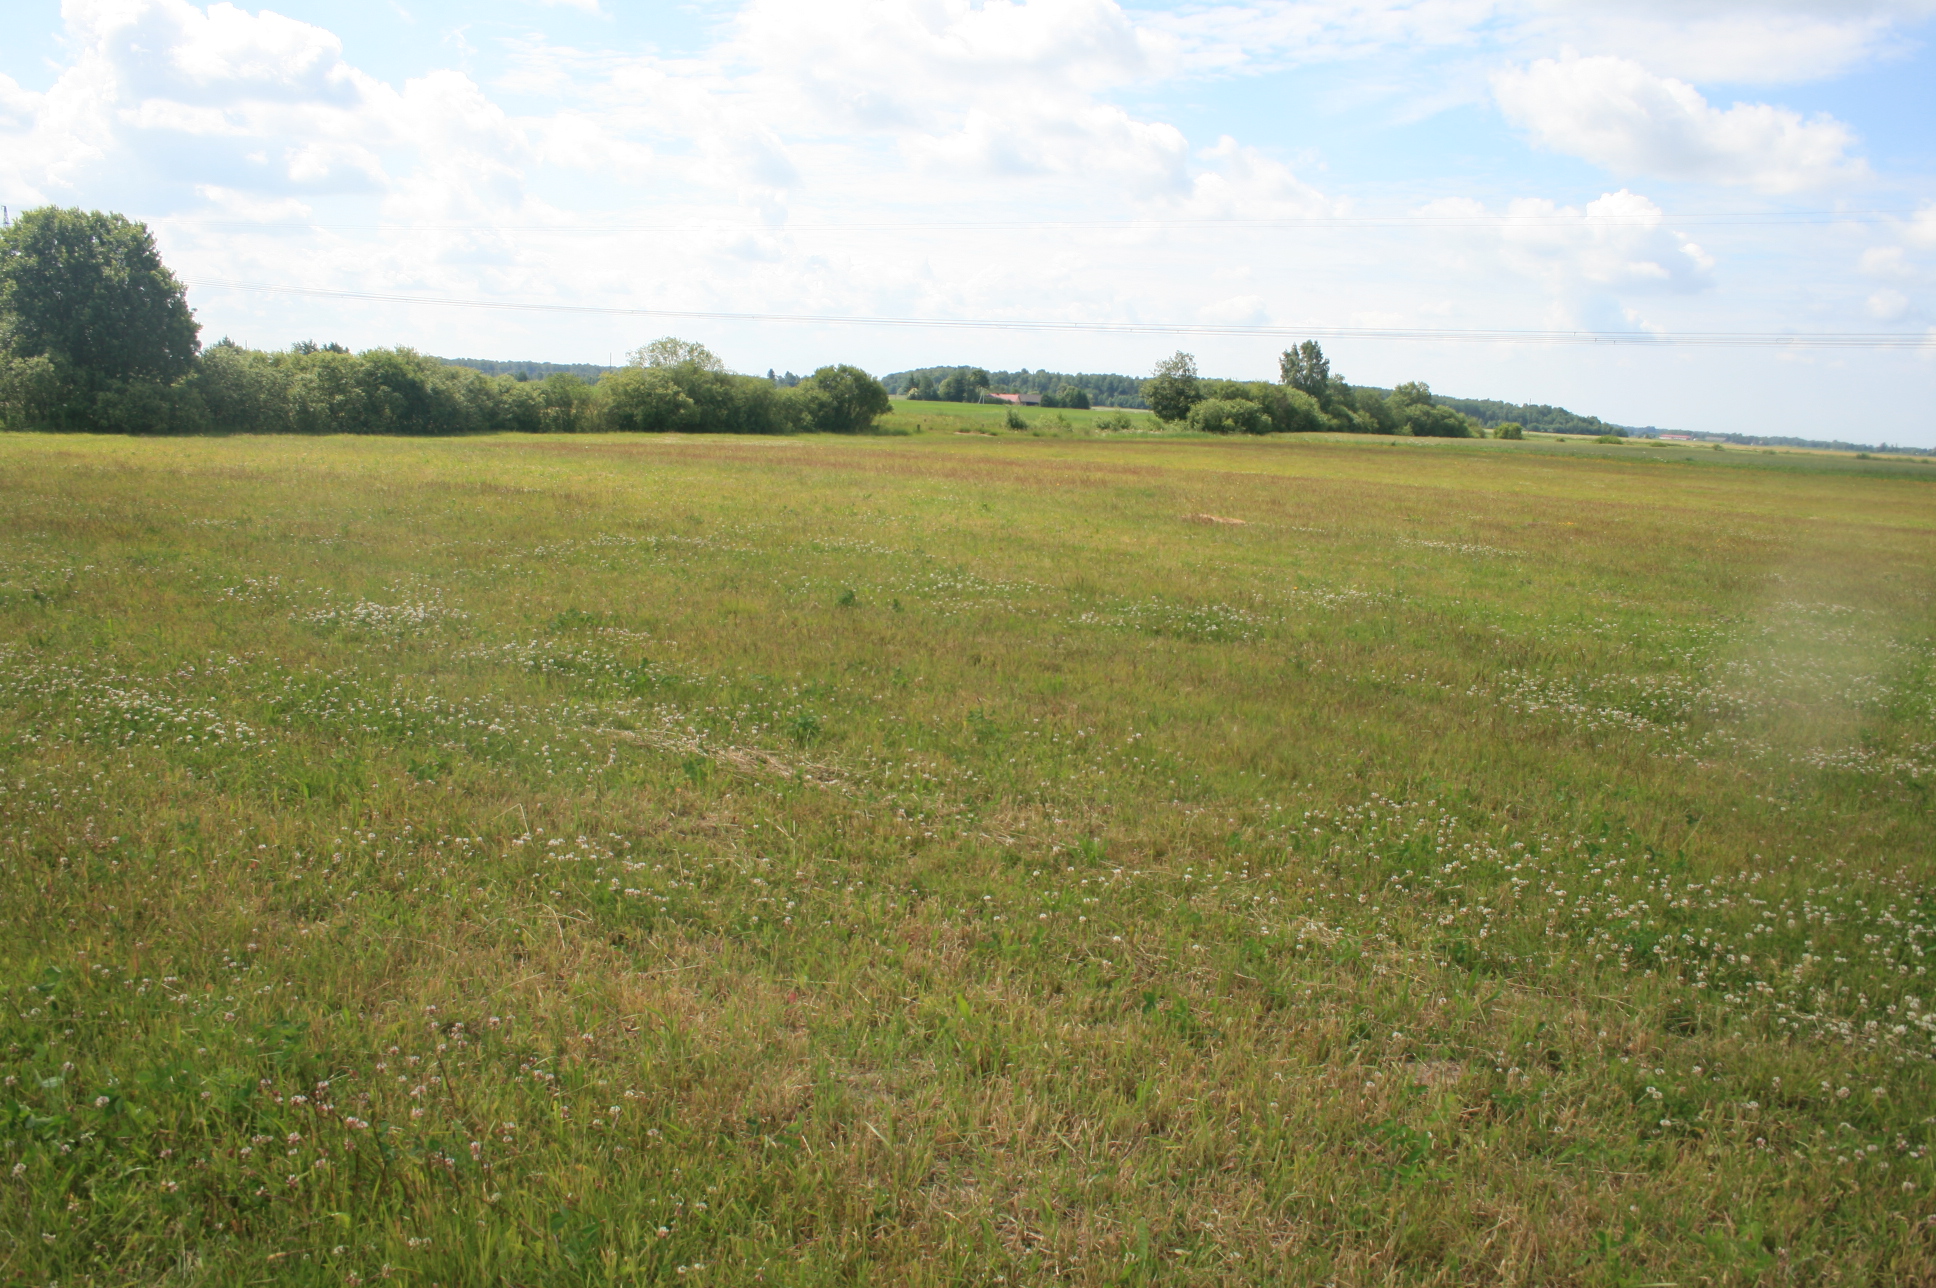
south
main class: Grassland
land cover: Grassland without tree/shrub cover
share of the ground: > 75 %
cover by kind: herbaceous plants 100 %
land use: Agriculture (excluding fallow land and kitchen gardens)
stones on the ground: < 10 %
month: June
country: LT
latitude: 55.3205
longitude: 21.7270
